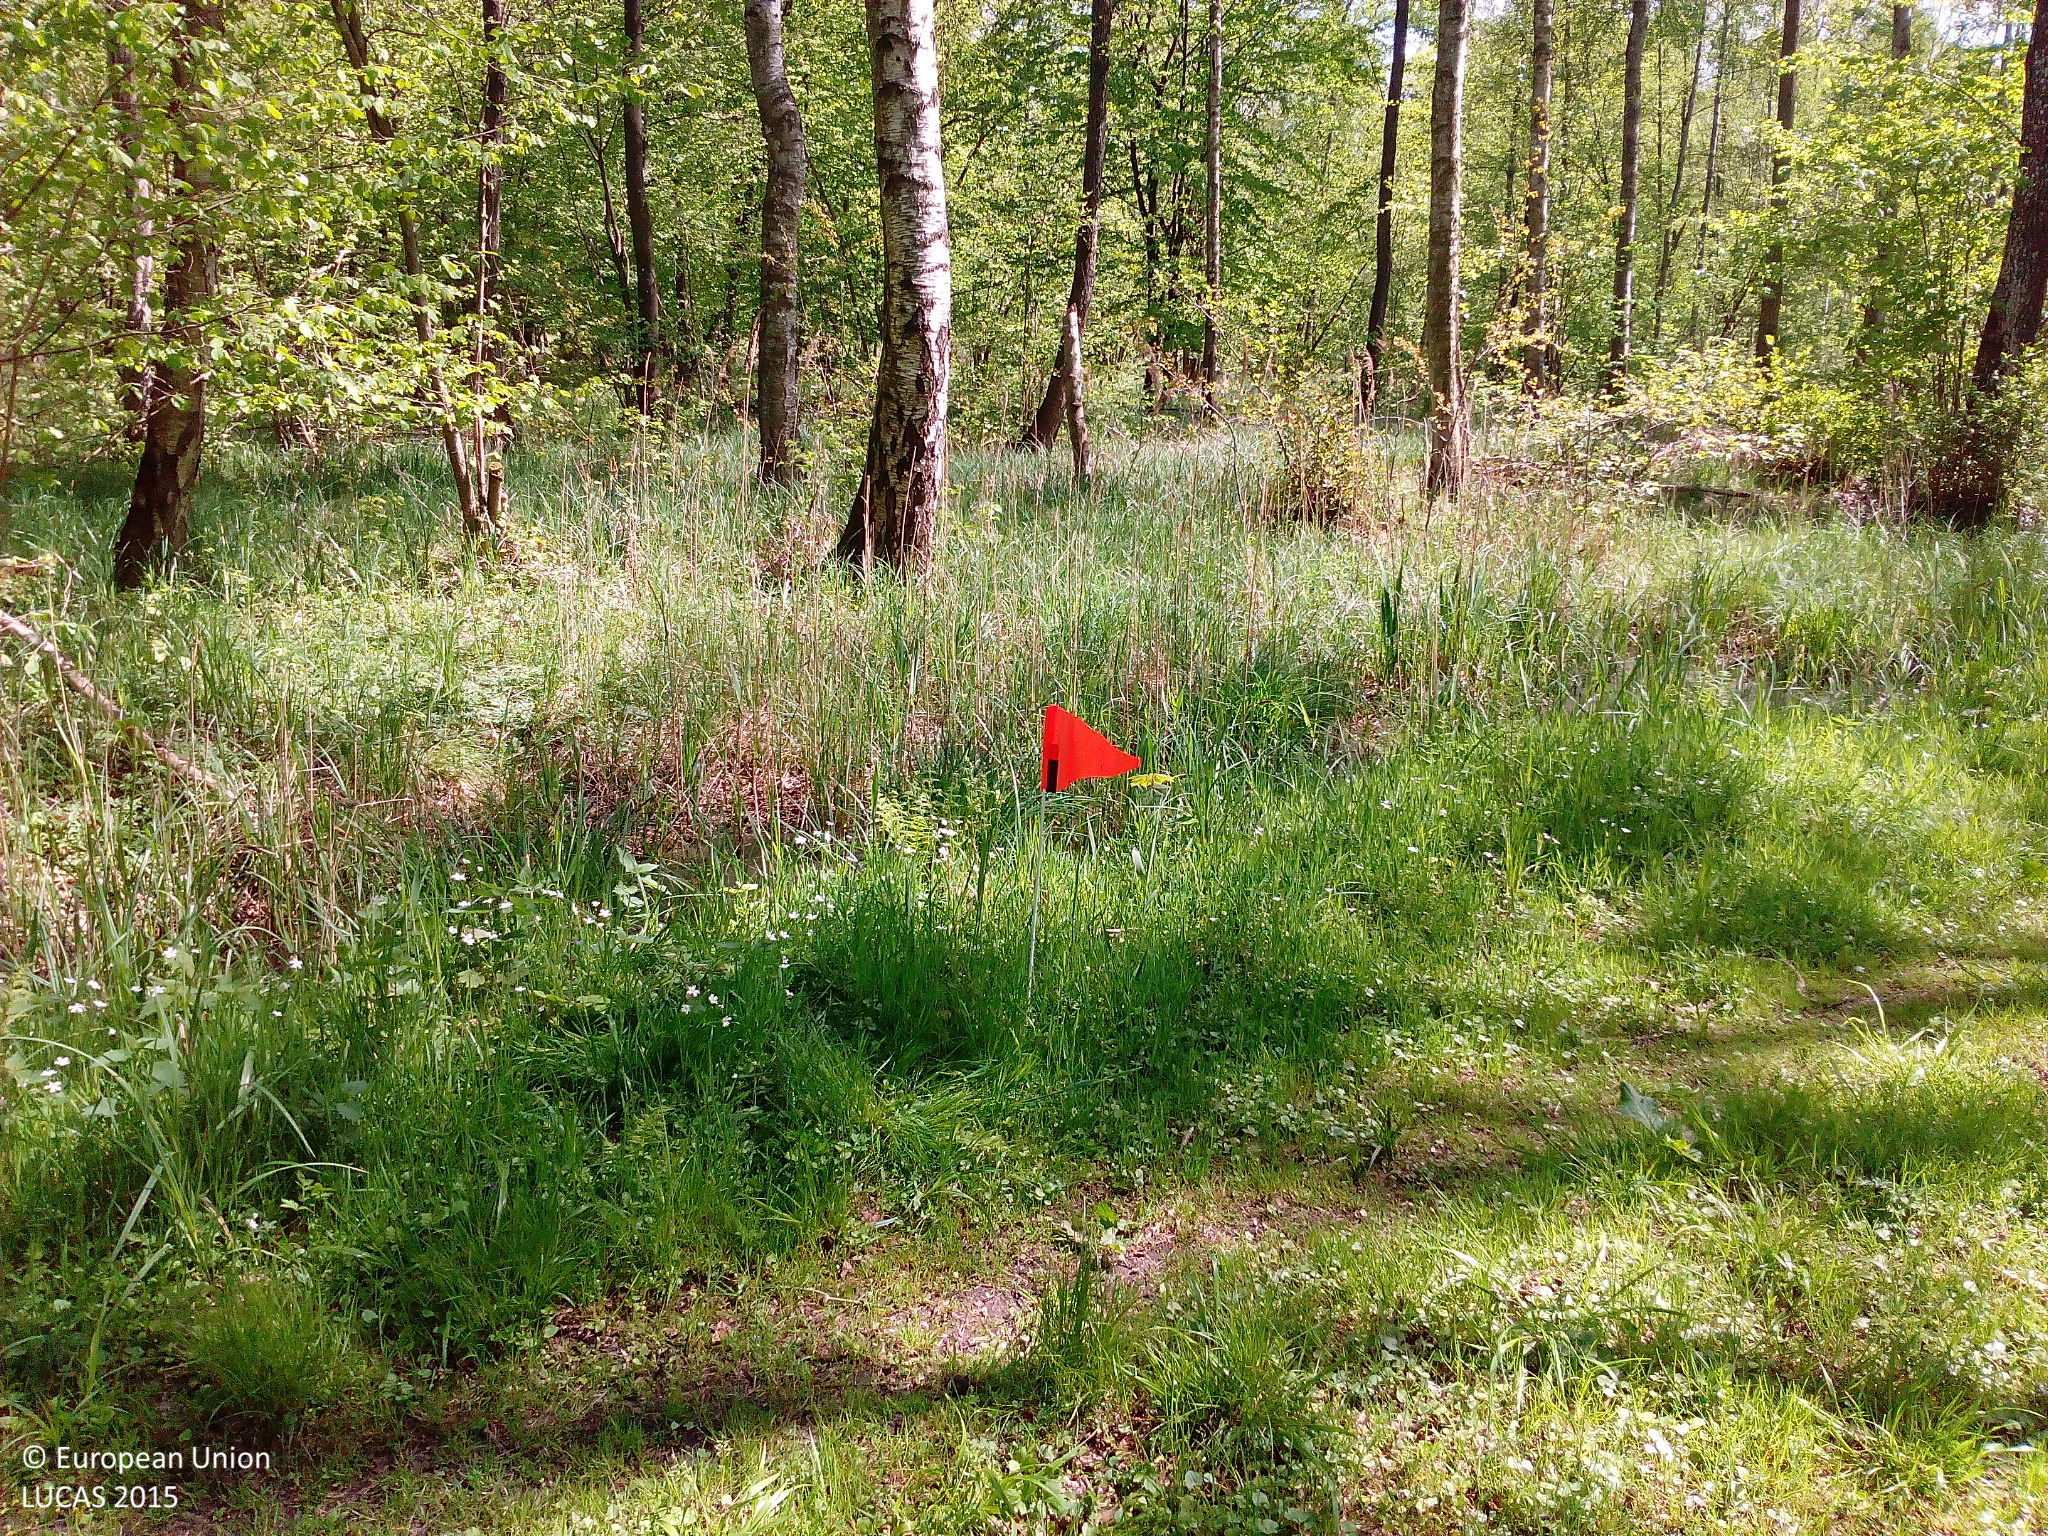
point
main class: Woodland
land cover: Broadleaved woodland
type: mesophytic deciduous forest
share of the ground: > 75 %
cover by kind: broadleaved forest trees 90 %, shrubs 5 %, herbaceous plants 5 %
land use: Forestry
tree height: > 5 m
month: May
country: DE
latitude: 54.3438
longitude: 12.6602
